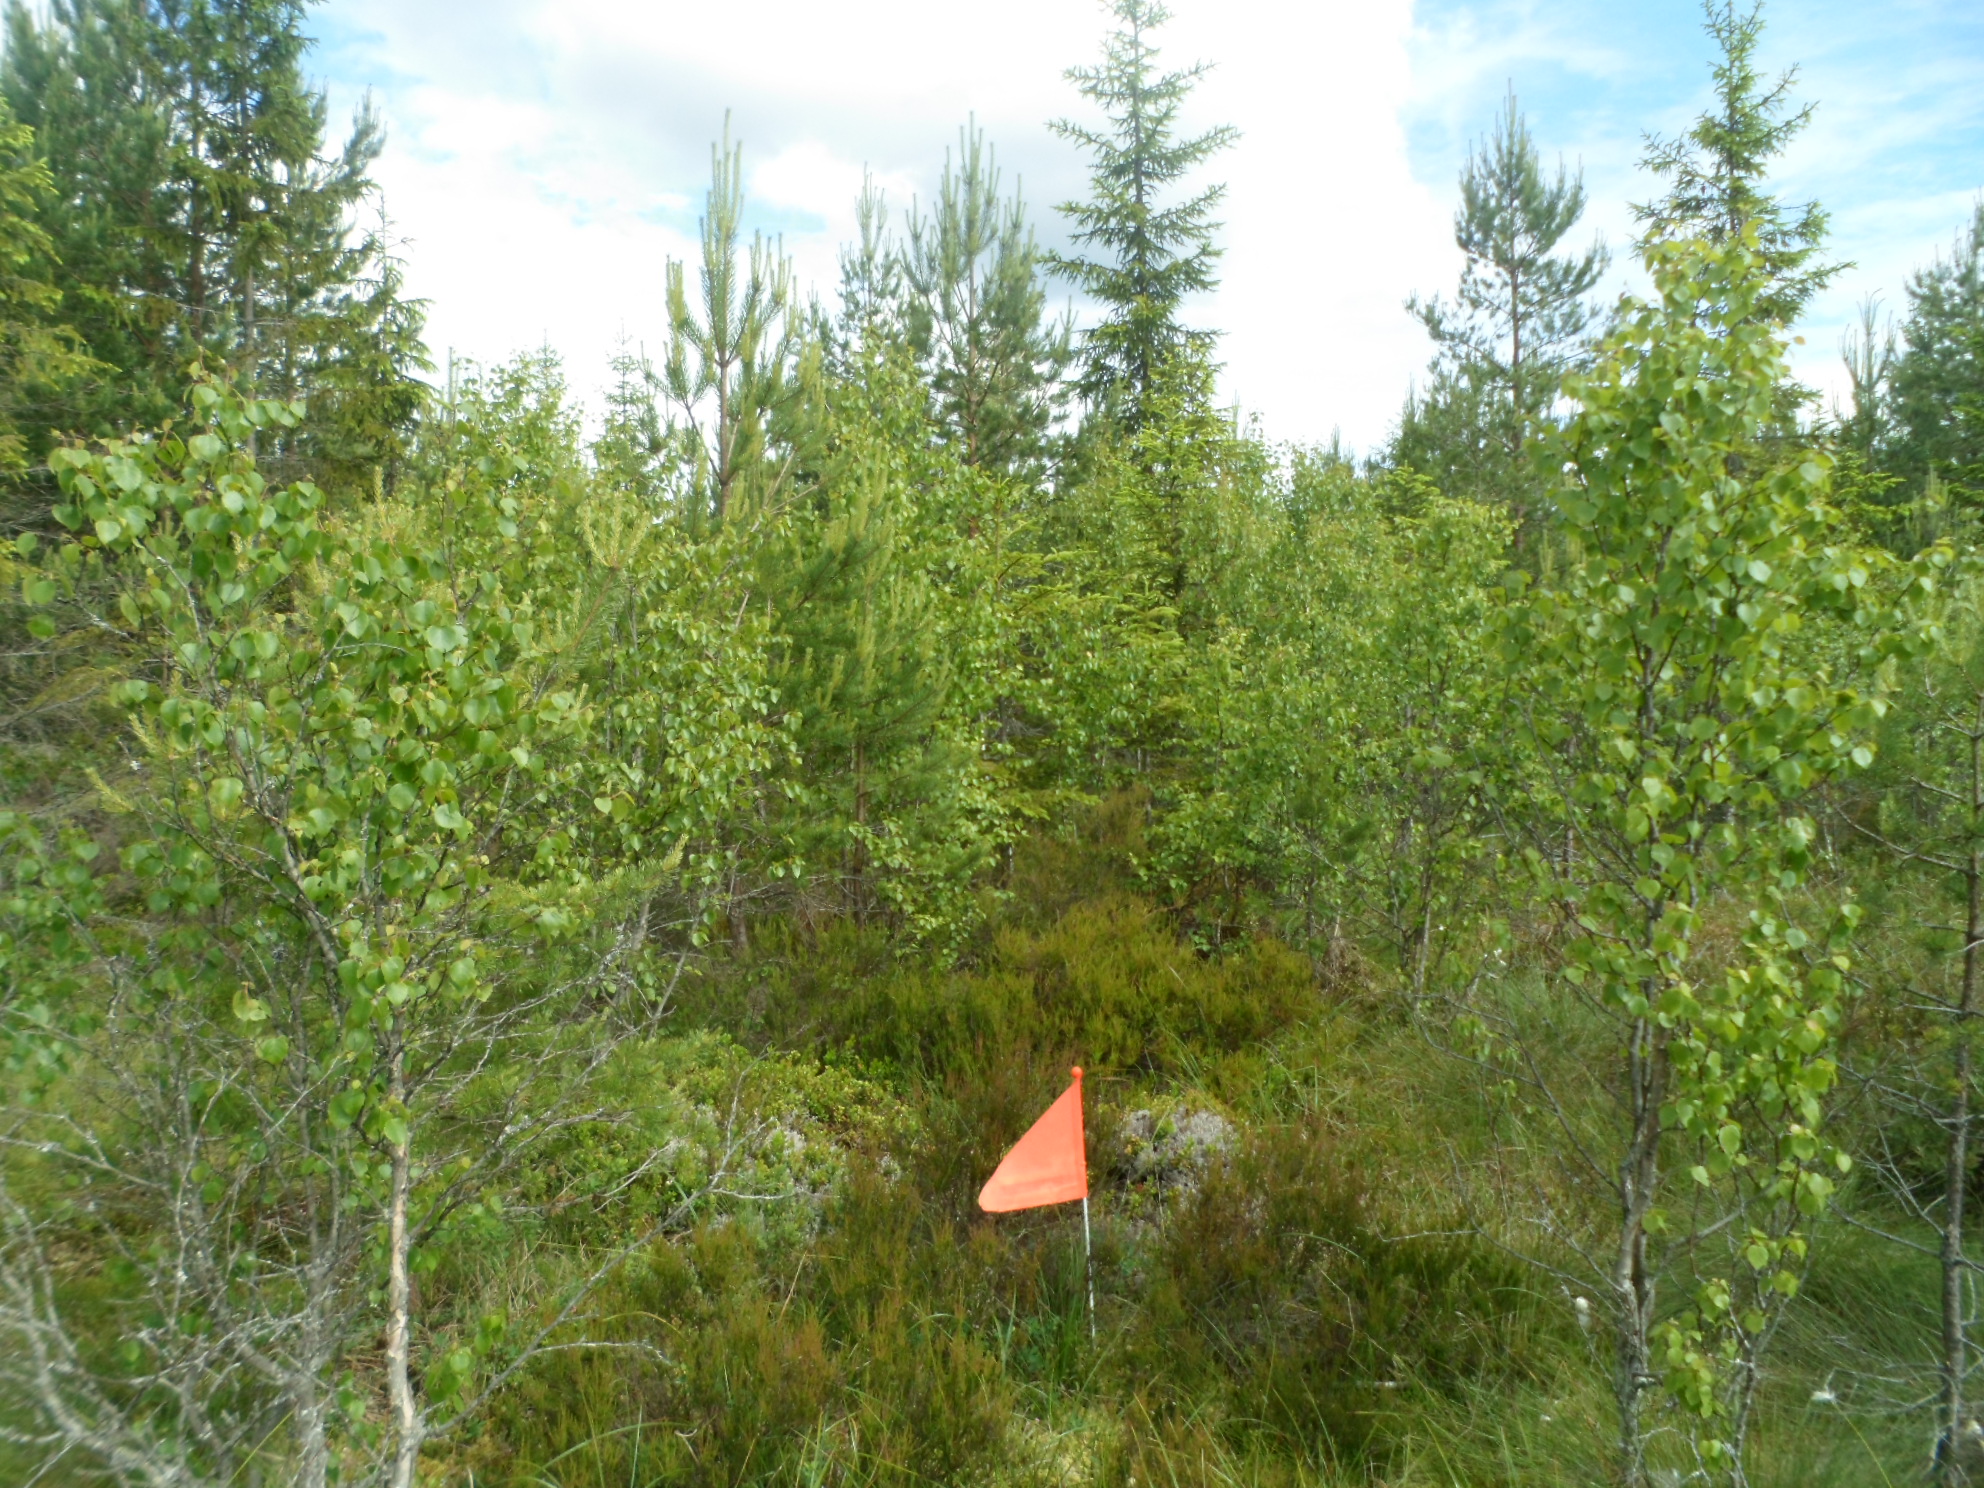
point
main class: Woodland
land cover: Pine dominated mixed woodland
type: boreal forest
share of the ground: 25 - 50 %
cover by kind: lichens and mosses 30 %, coniferous forest trees 20 %, broadleaved forest trees 20 %, shrubs 20 %, herbaceous plants 10 %
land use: Forestry
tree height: > 5 m
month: June
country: SE
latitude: 56.9721
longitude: 15.4759
